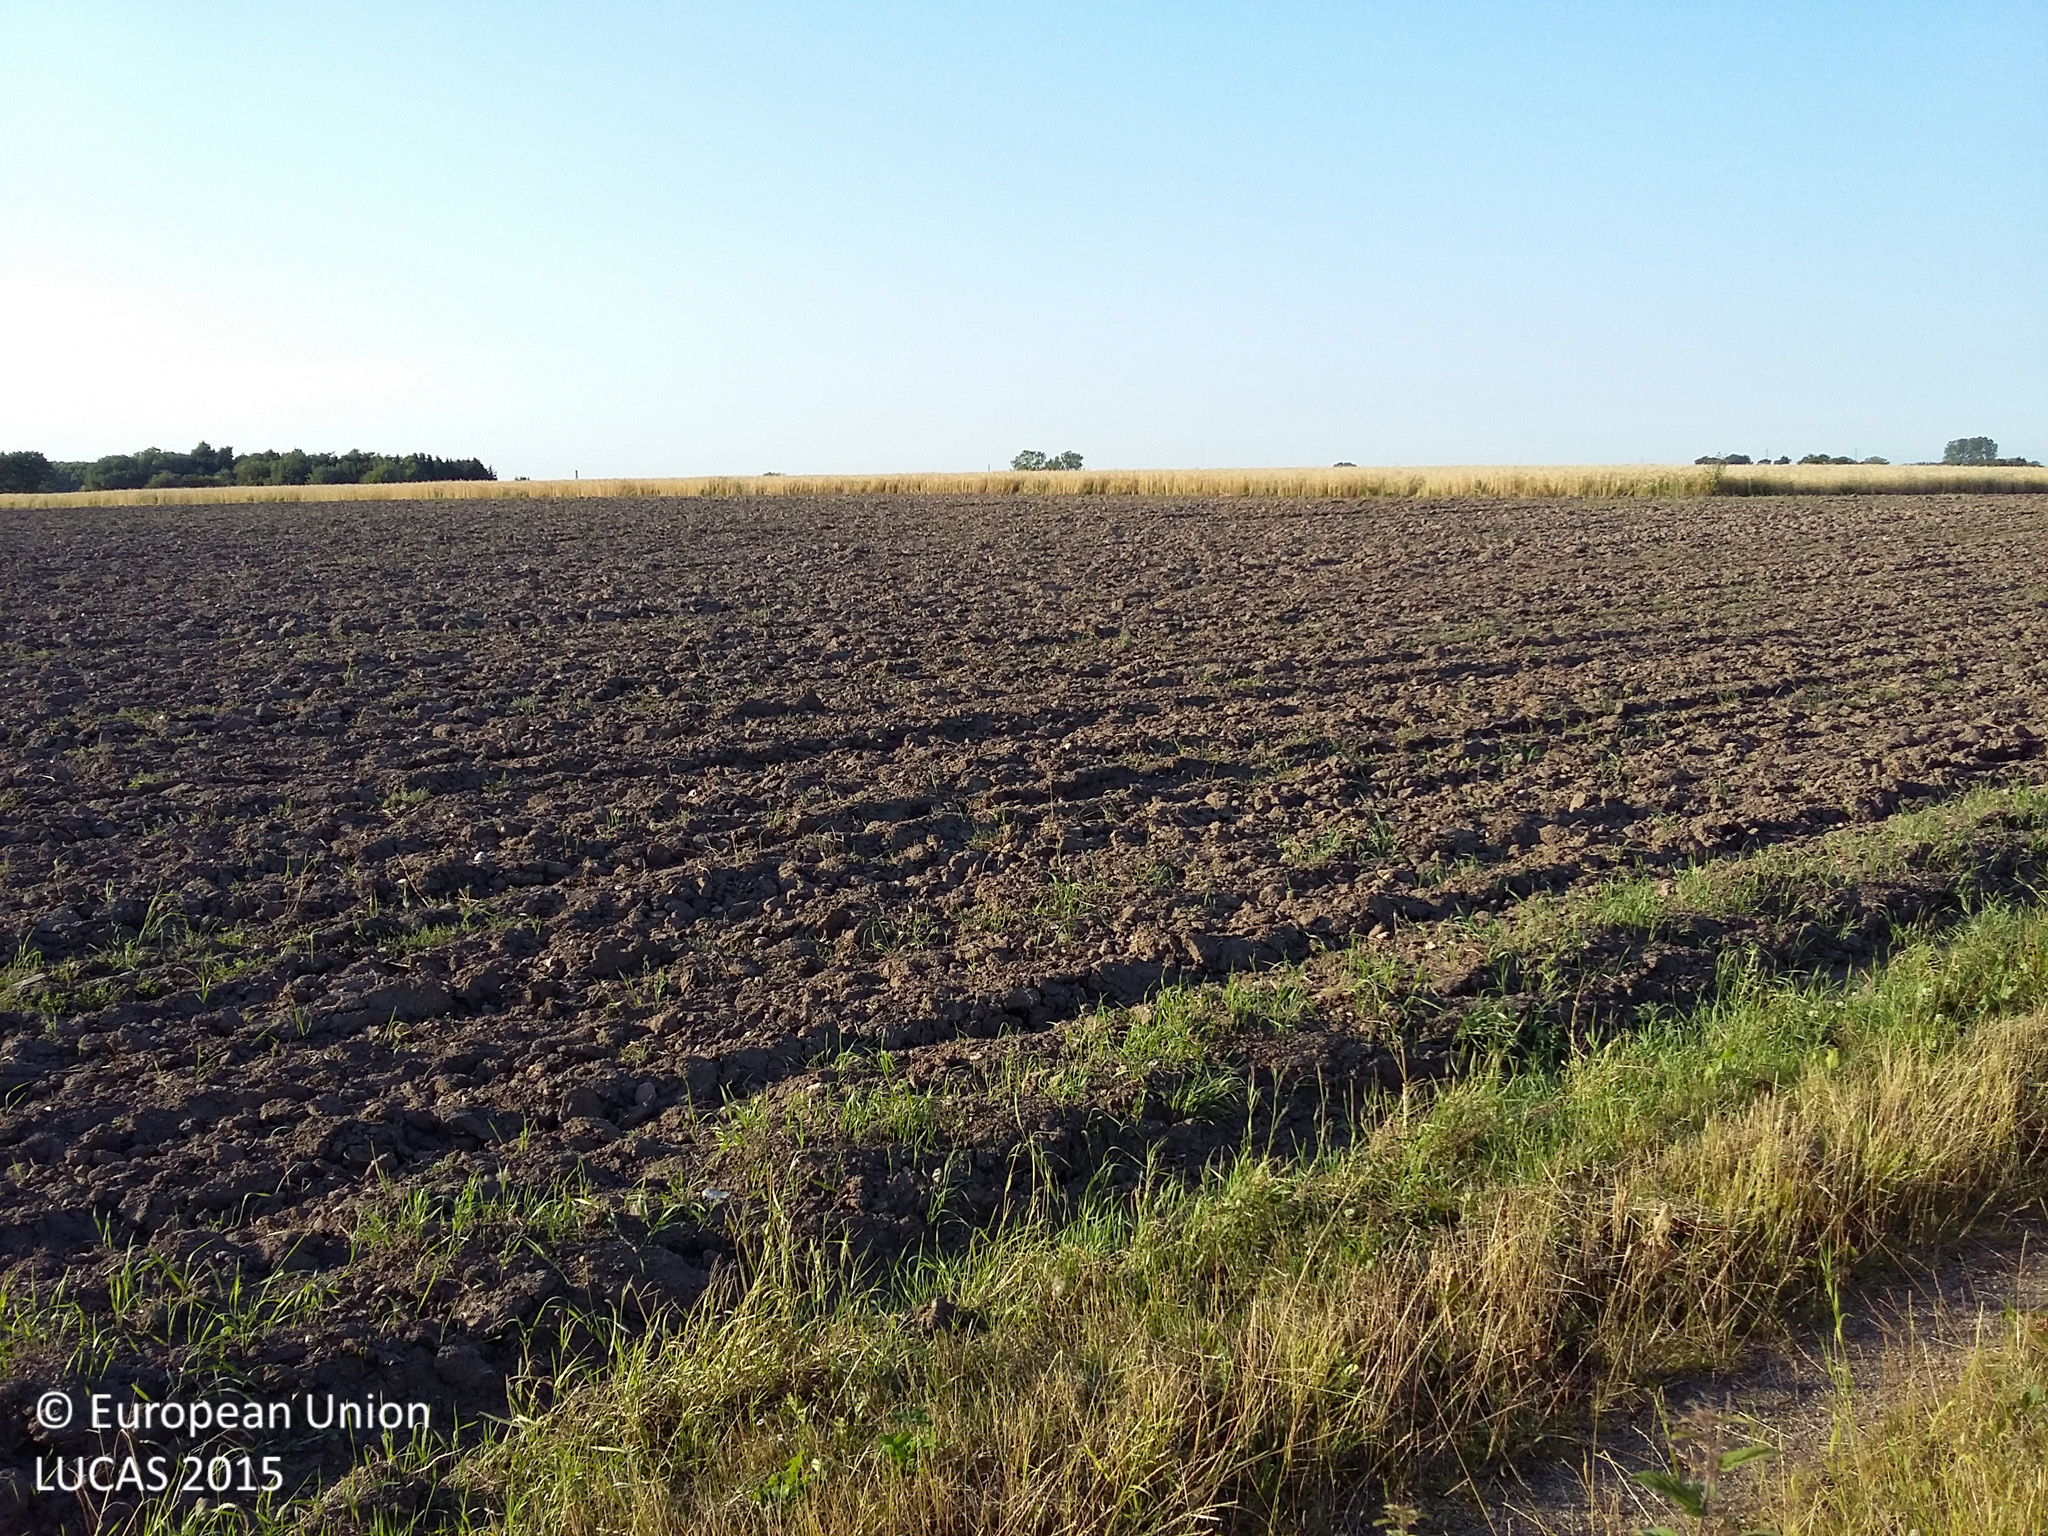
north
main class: Woodland
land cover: Broadleaved woodland
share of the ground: 25 - 50 %
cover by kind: herbaceous plants 60 %, broadleaved forest trees 40 %
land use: Agriculture (excluding fallow land and kitchen gardens)
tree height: > 5 m
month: August
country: DK
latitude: 55.6294
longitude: 12.2059
